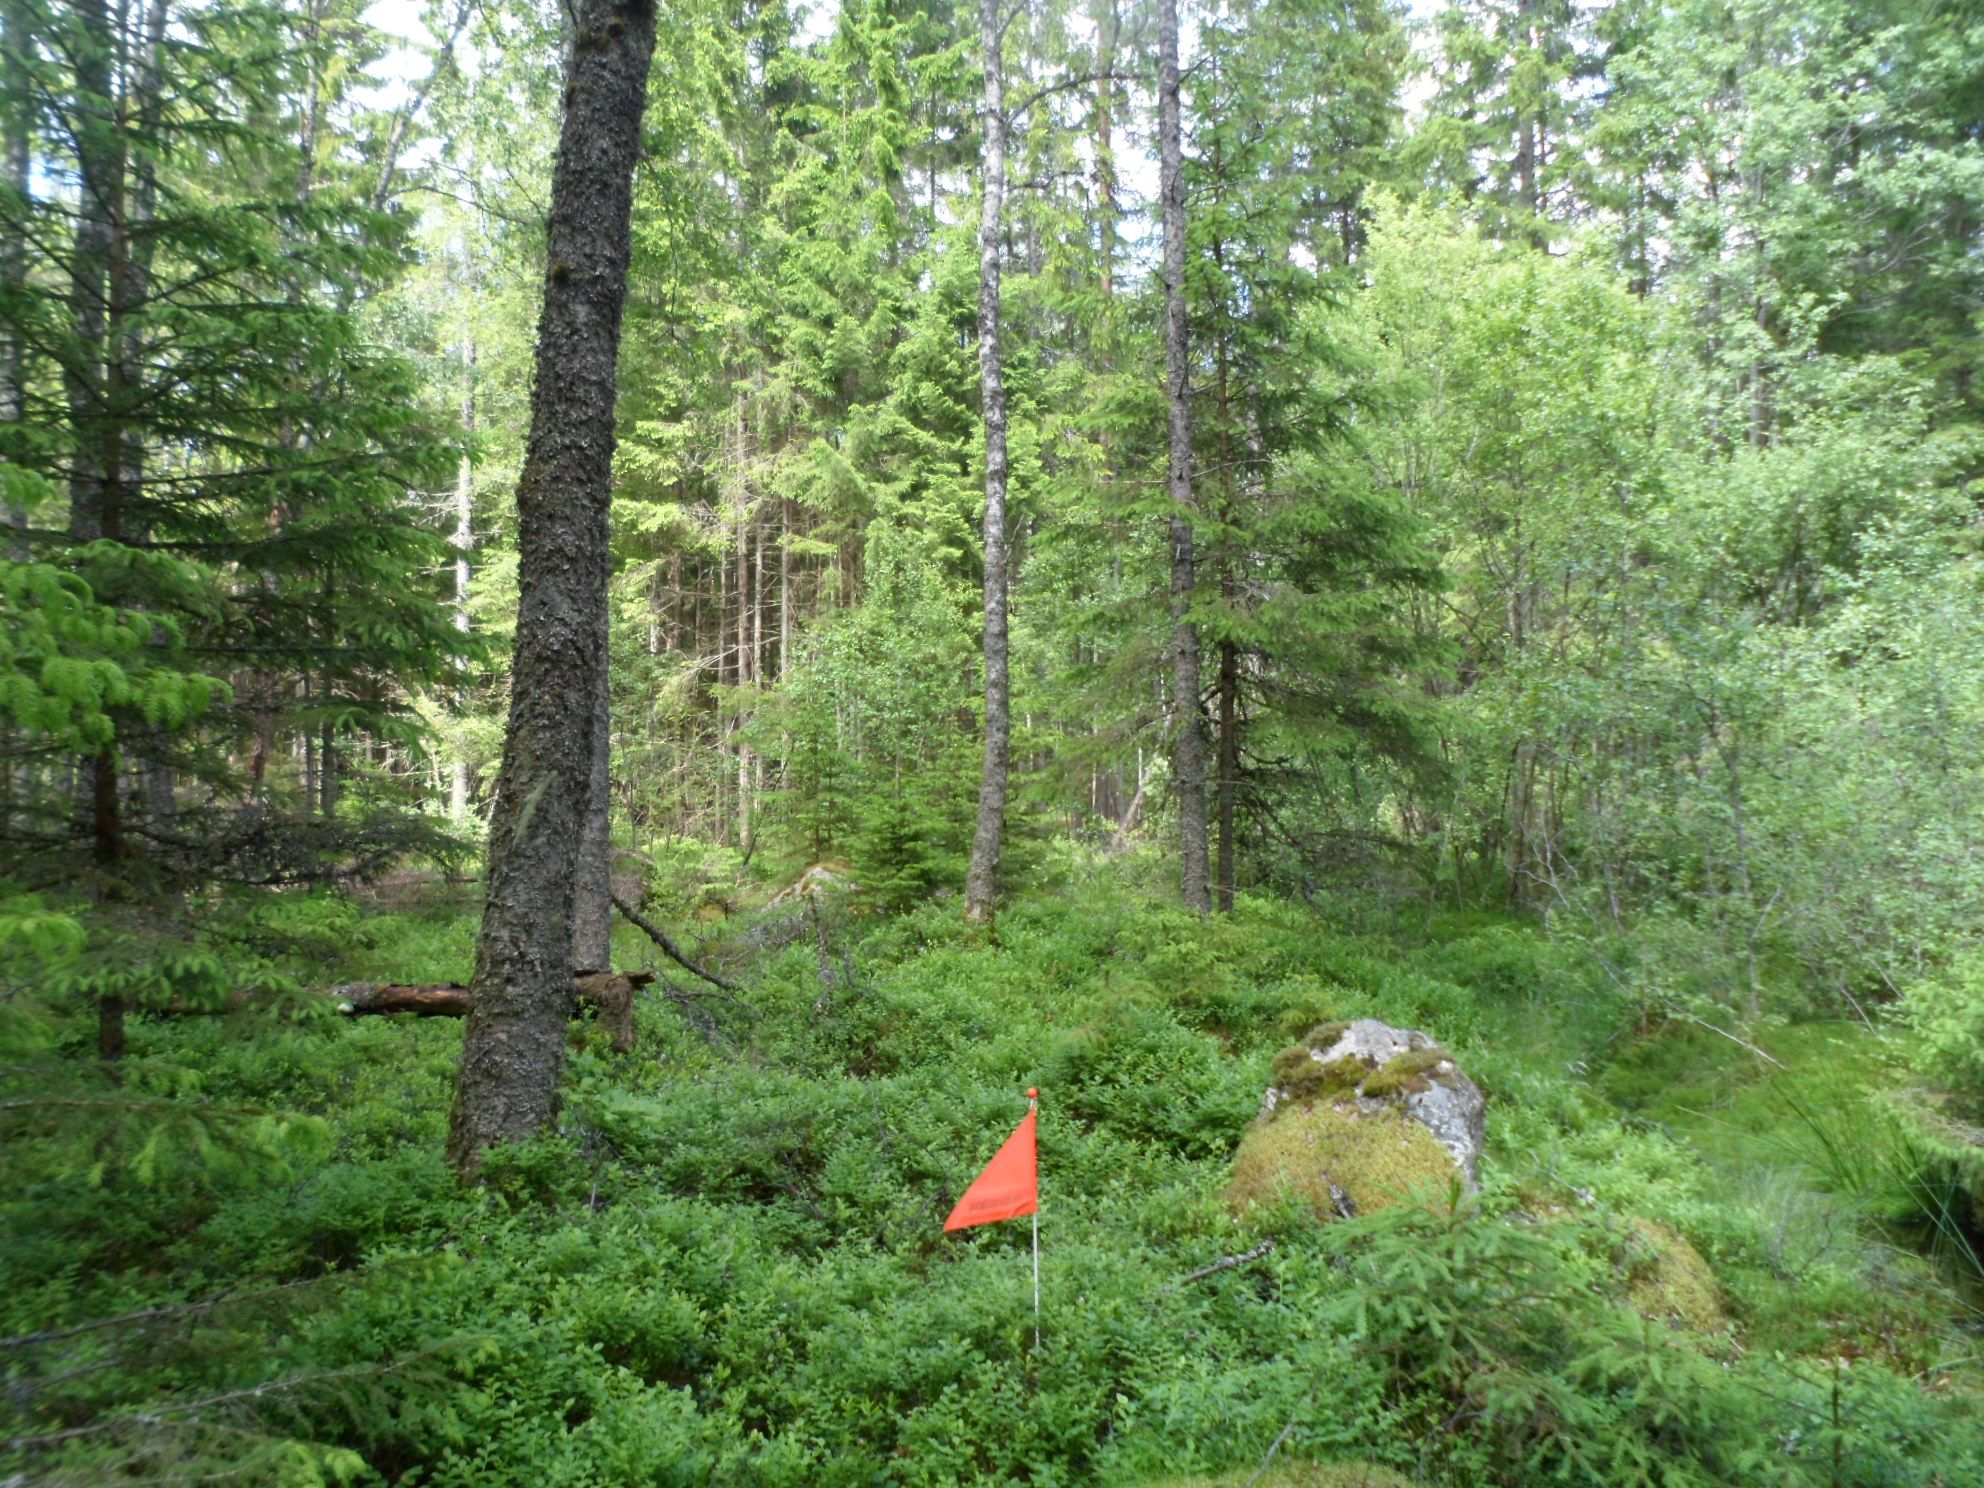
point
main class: Woodland
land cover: Spruce dominated mixed woodland
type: boreal forest
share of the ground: 50 - 75 %
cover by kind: coniferous forest trees 35 %, broadleaved forest trees 30 %, shrubs 25 %, herbaceous plants 5 %, lichens and mosses 5 %
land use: Forestry
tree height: > 5 m
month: June
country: SE
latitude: 57.0510
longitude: 14.3320
